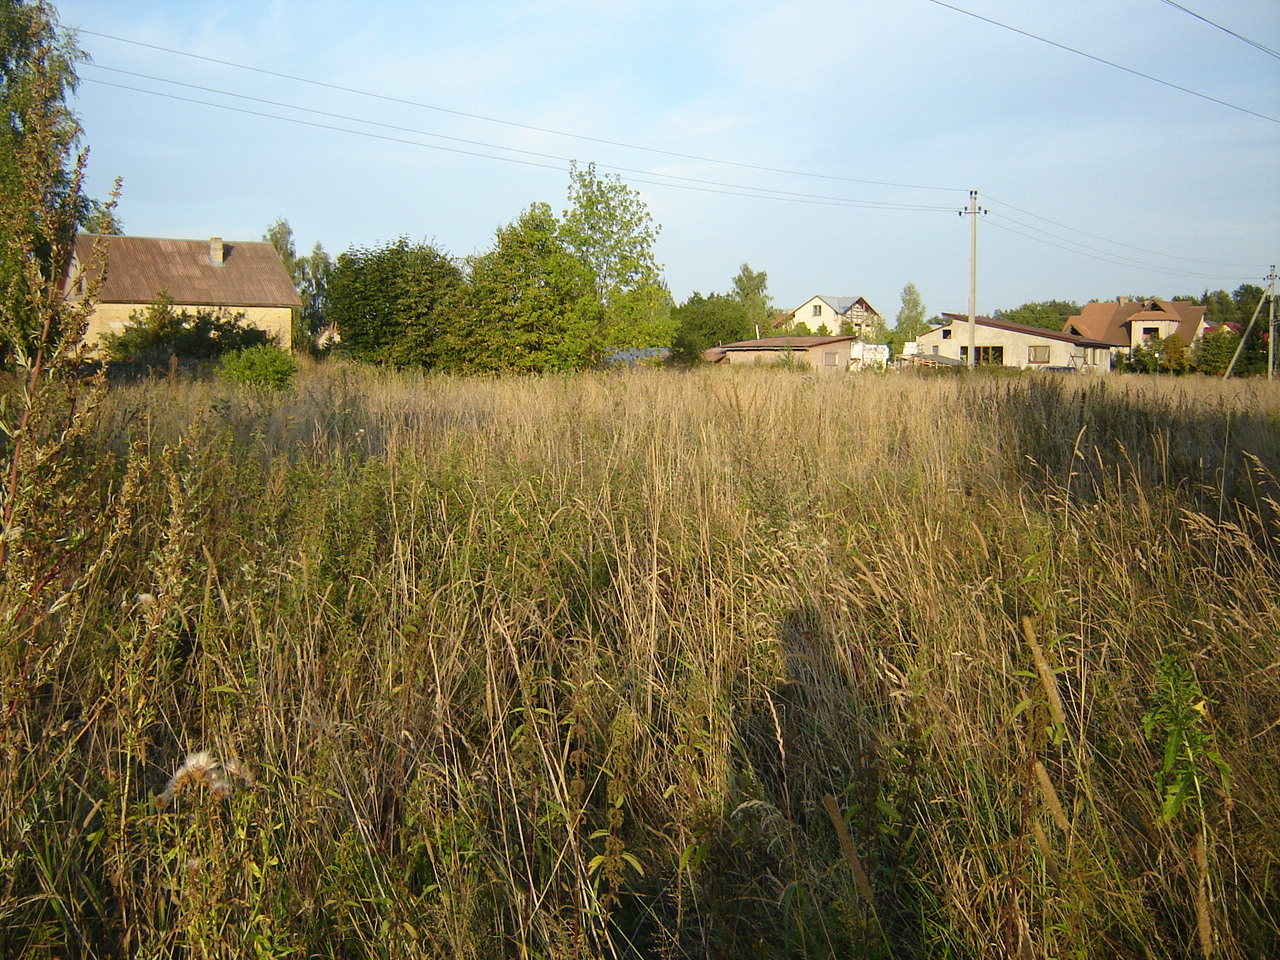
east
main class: Grassland
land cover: Grassland with sparse tree/shrub cover
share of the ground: > 75 %
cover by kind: herbaceous plants 95 %, broadleaved forest trees 5 %
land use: Fallow land
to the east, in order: Grassland with sparse tree/shrub cover; Electric lines; Spontaneously vegetated surfaces; Electric lines; Spontaneously vegetated surfaces; Grassland without tree/shrub cover; Artificial constructions in urban areas
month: August
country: LT
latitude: 54.5812
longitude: 25.1732
